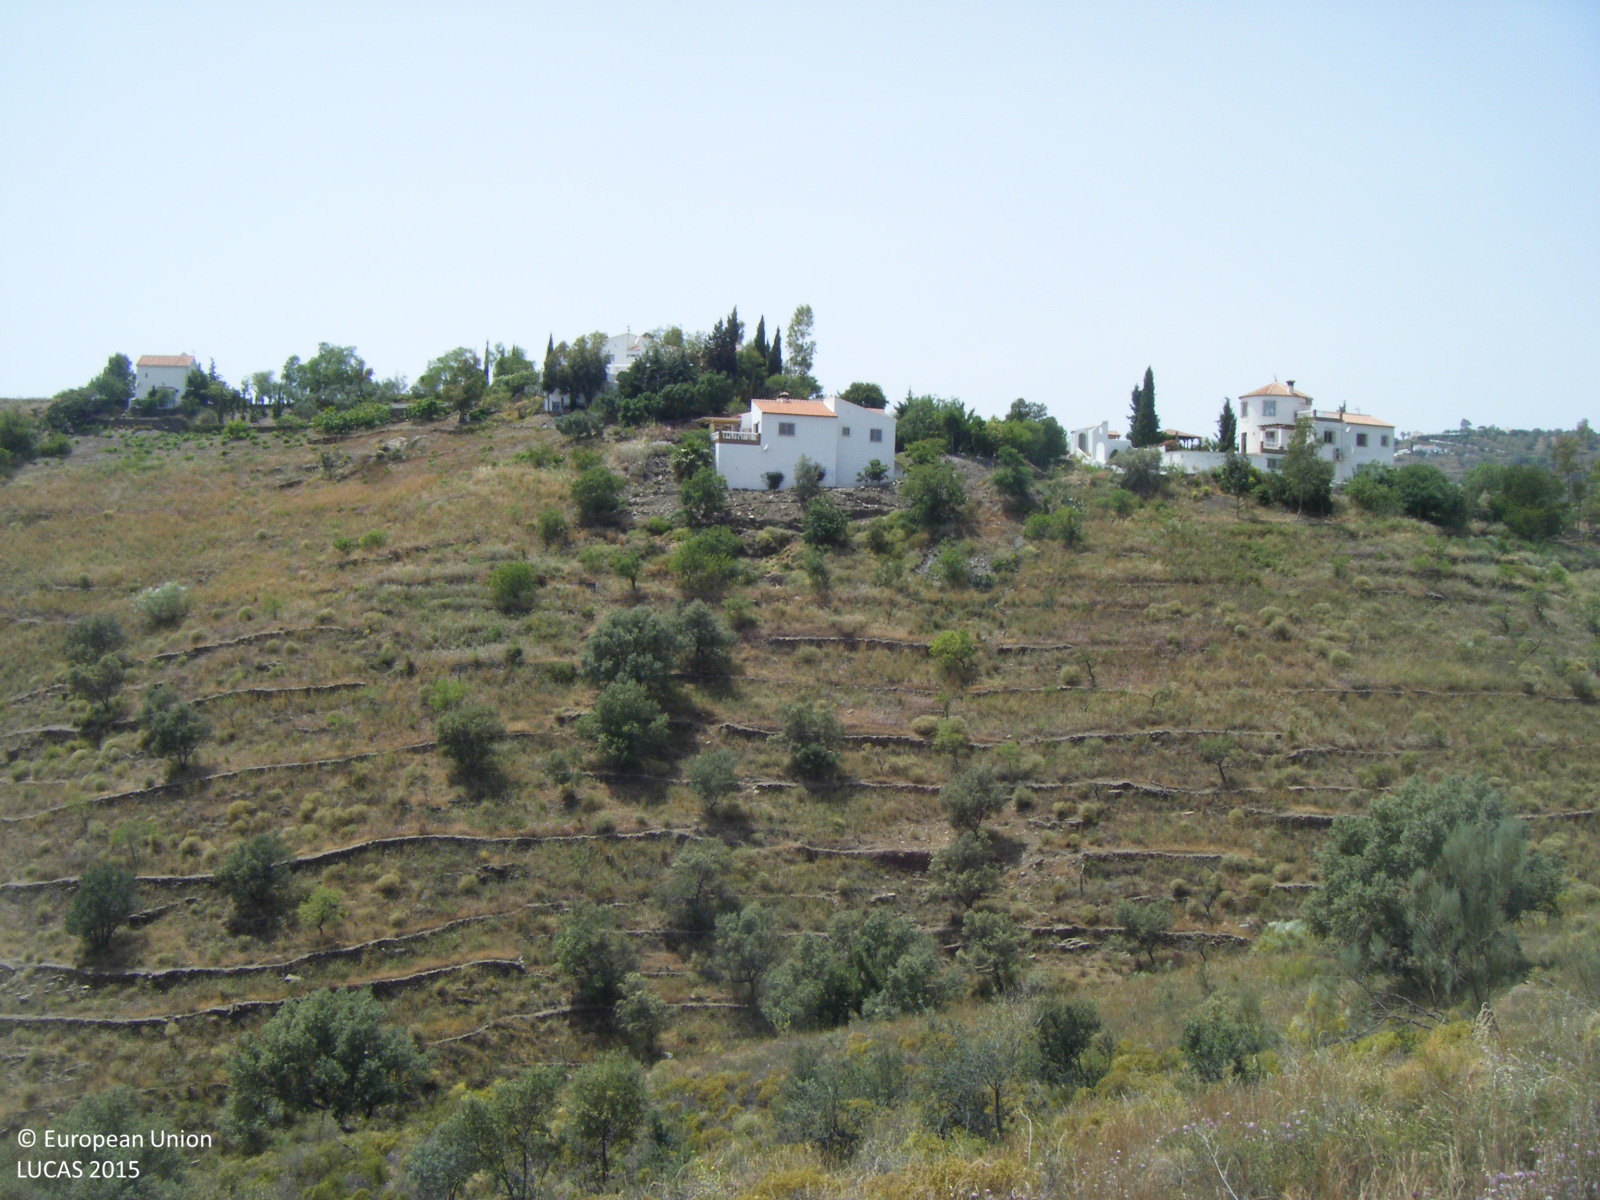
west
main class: Grassland
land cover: Grassland without tree/shrub cover
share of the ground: > 75 %
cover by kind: herbaceous plants 95 %, shrubs 5 %
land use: Semi-natural and natural areas not in use
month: May
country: ES
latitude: 36.7793
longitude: -4.0036
